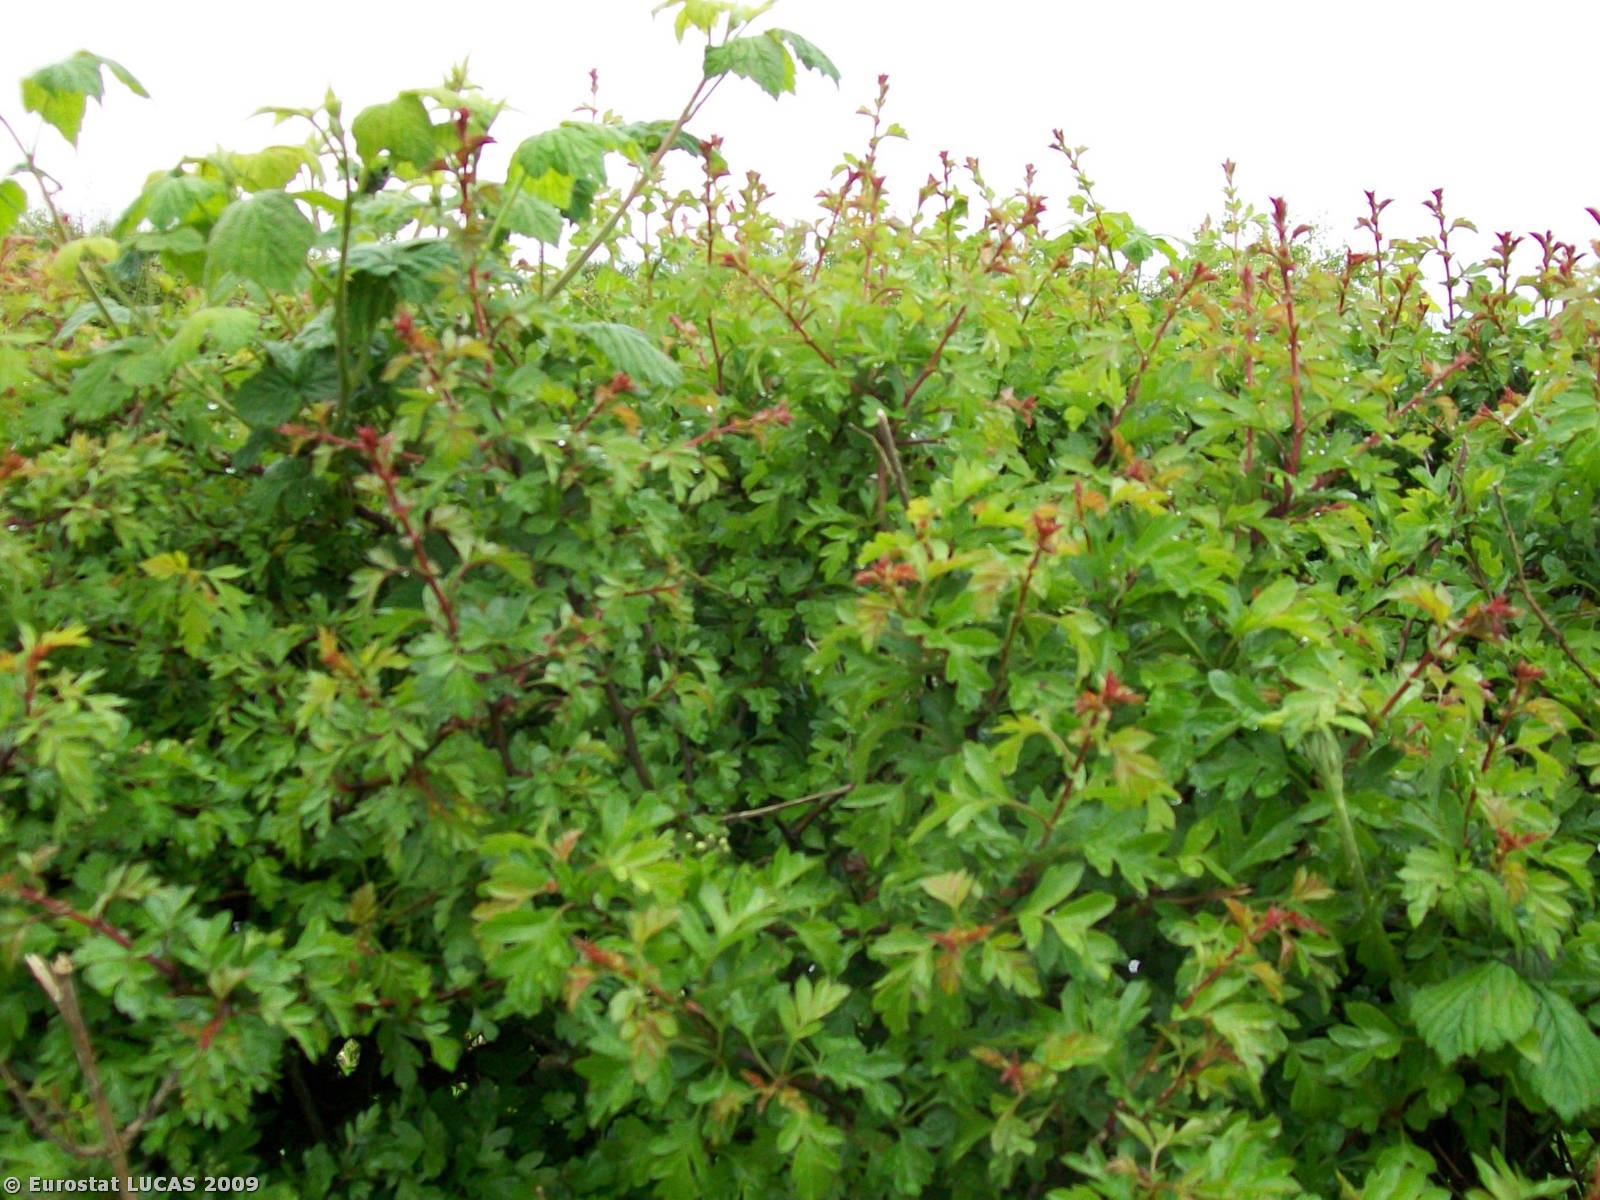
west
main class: Cropland
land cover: Common wheat
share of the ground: 50 - 75 %
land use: Agriculture (excluding fallow land and kitchen gardens)
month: May
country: GB
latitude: 53.8012
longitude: -2.9019
